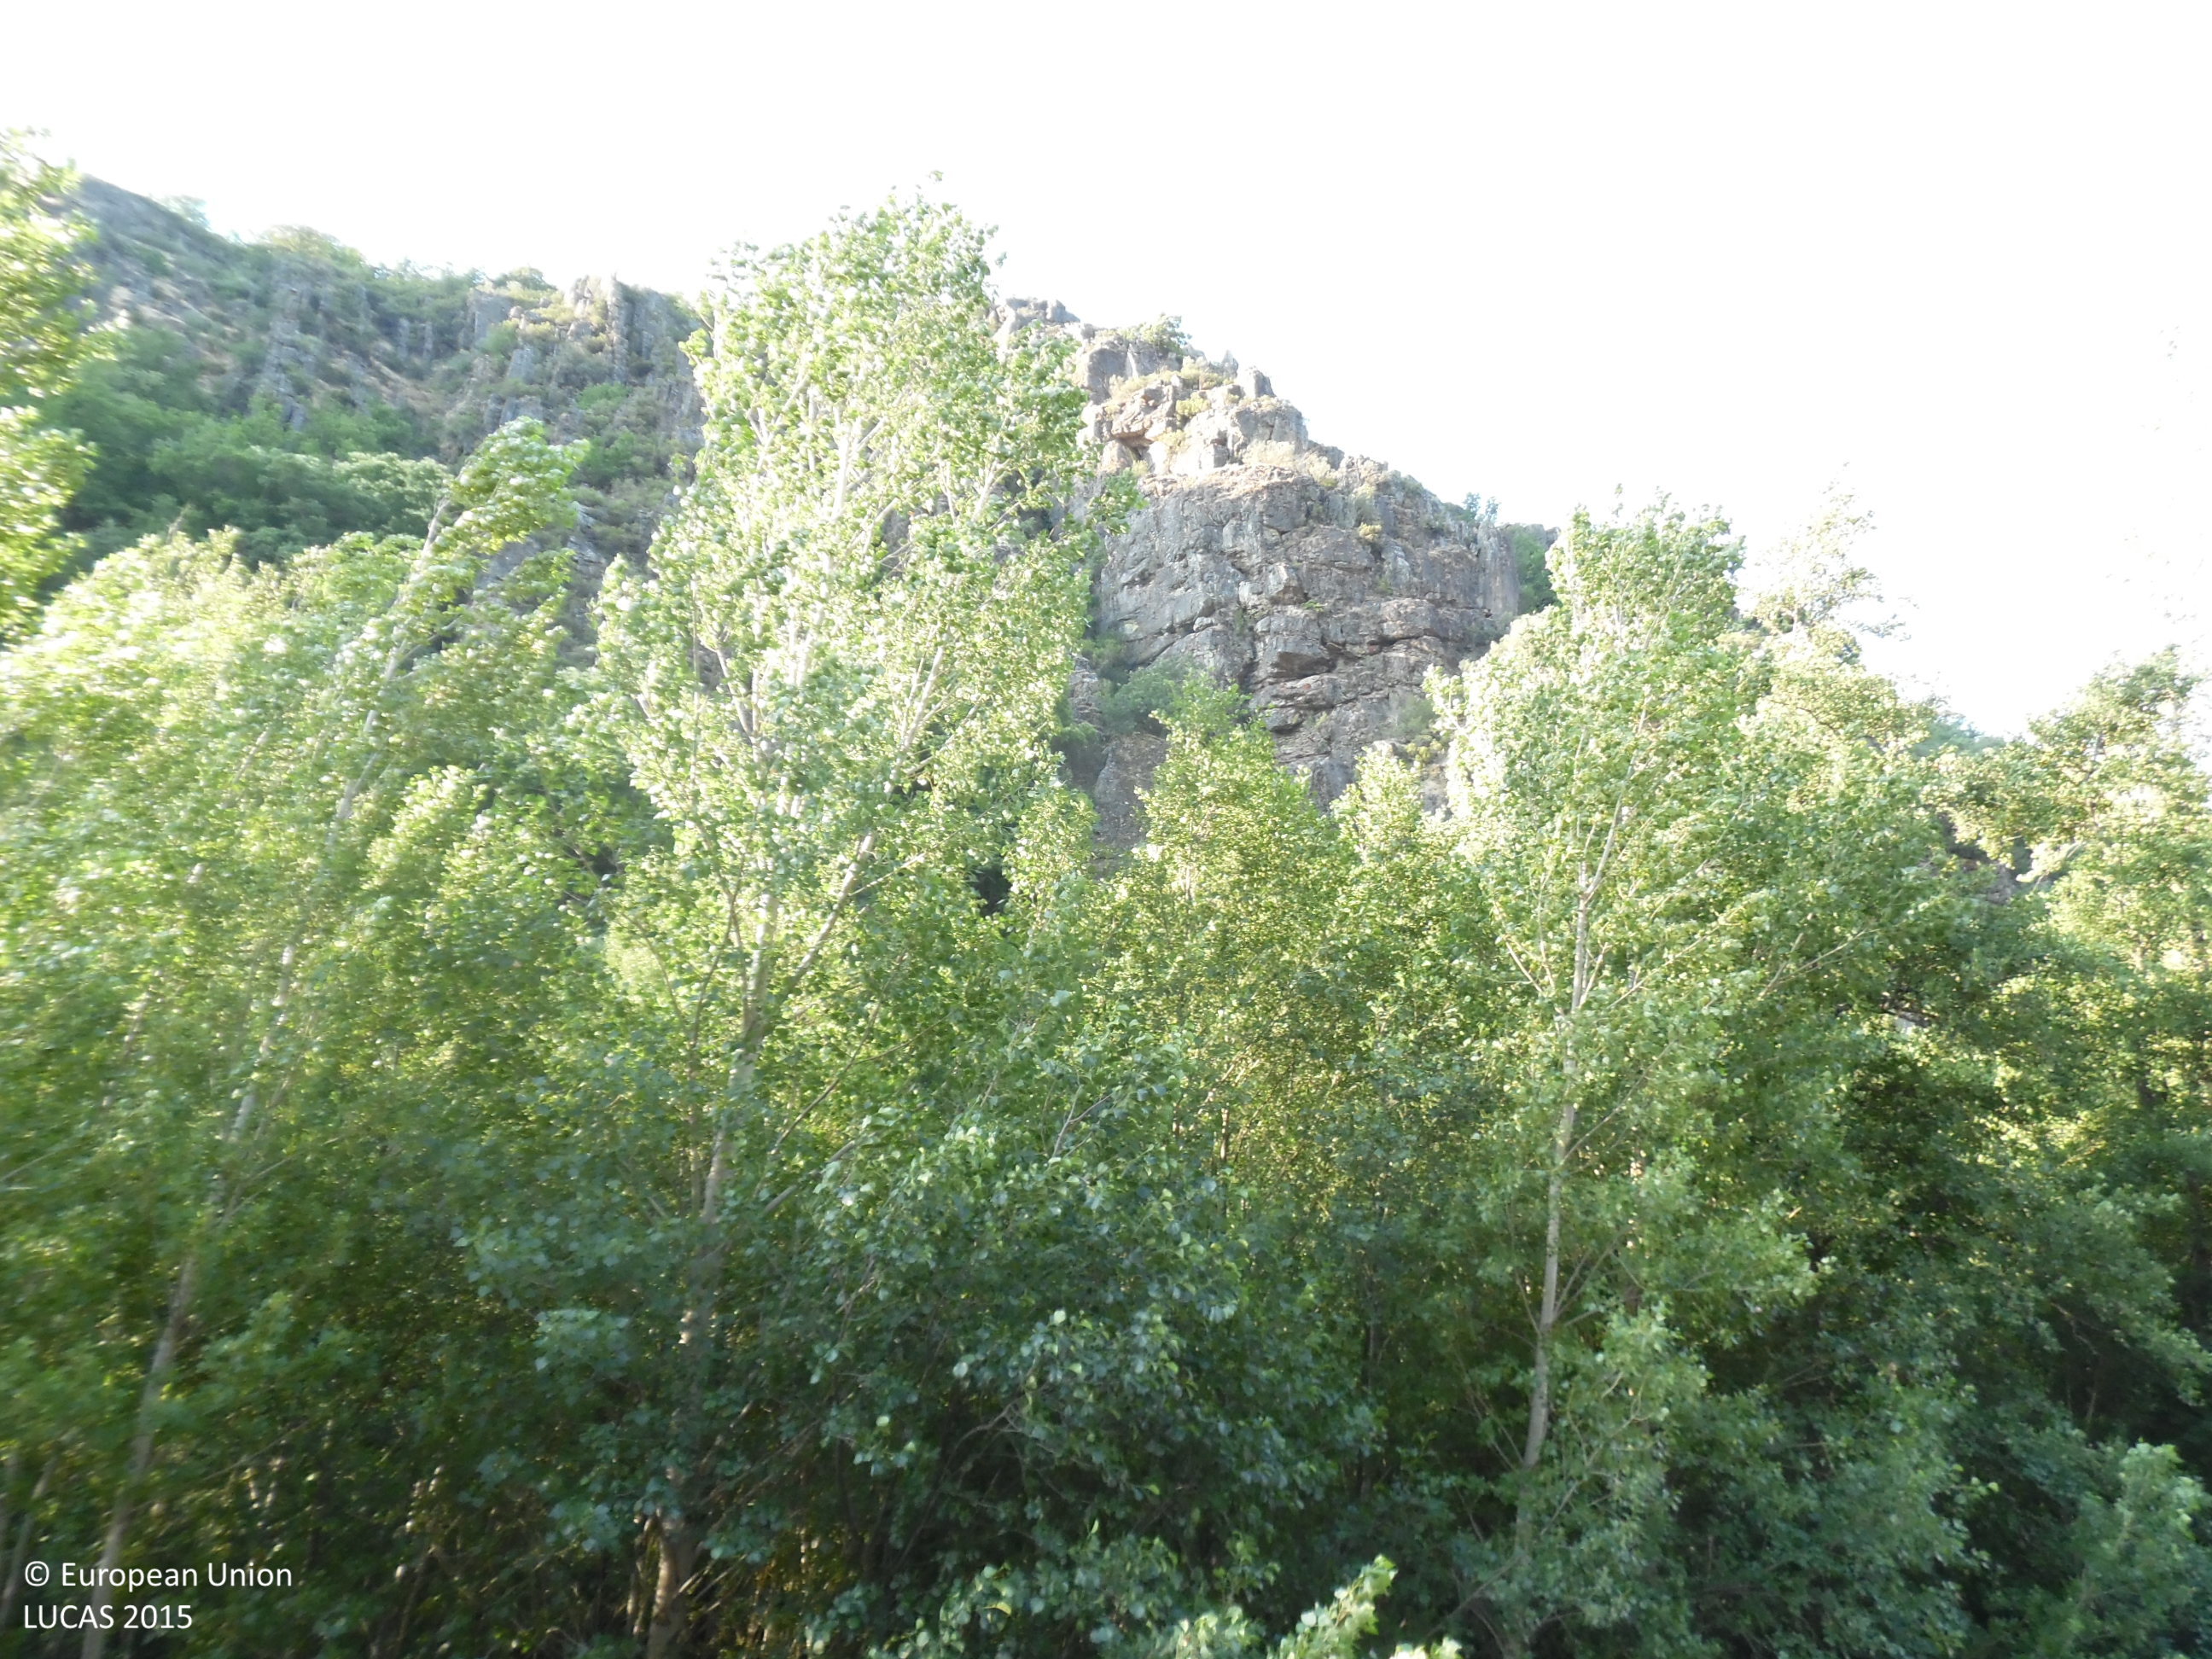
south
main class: Woodland
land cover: Broadleaved woodland
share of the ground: > 75 %
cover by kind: broadleaved forest trees 80 %, shrubs 5 %
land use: Forestry
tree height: > 5 m
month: June
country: ES
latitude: 42.8383
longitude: -6.4783
